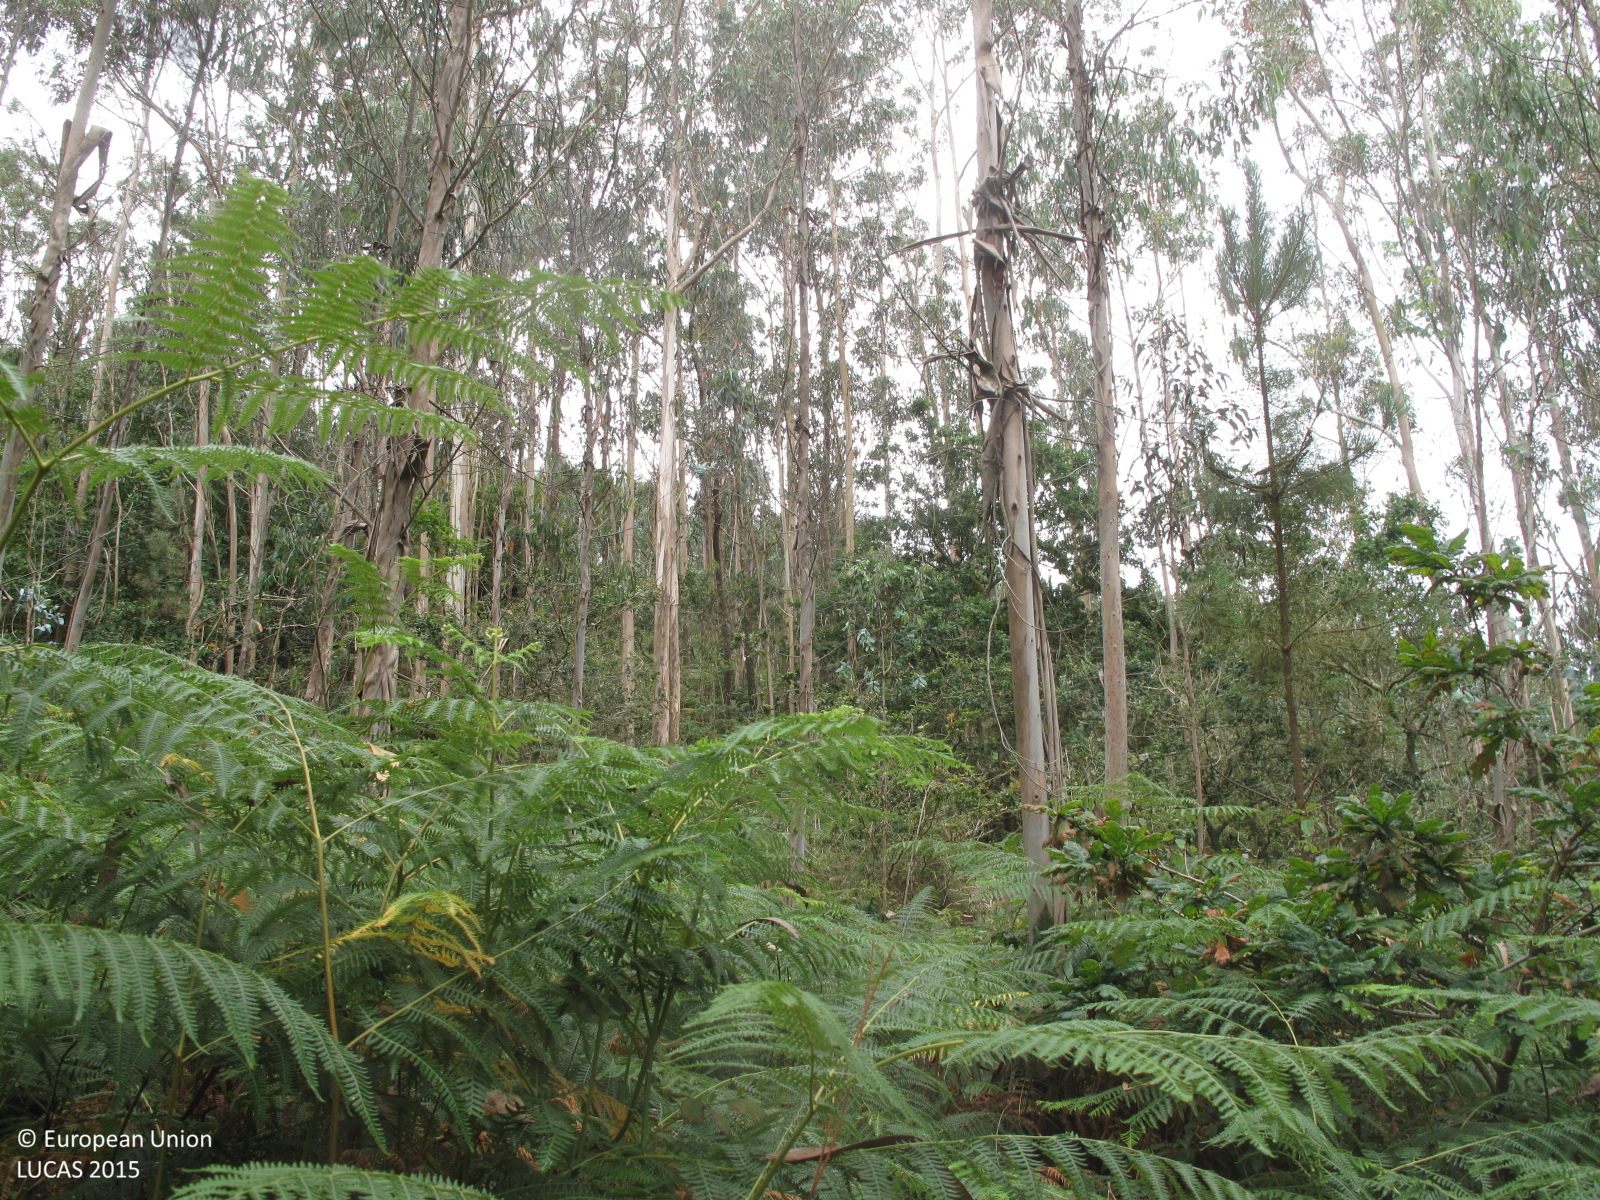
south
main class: Woodland
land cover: Broadleaved woodland
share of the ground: 25 - 50 %
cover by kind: herbaceous plants 50 %, broadleaved forest trees 40 %, shrubs 10 %
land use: Forestry
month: July
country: ES
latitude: 43.0554
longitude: -9.1959
